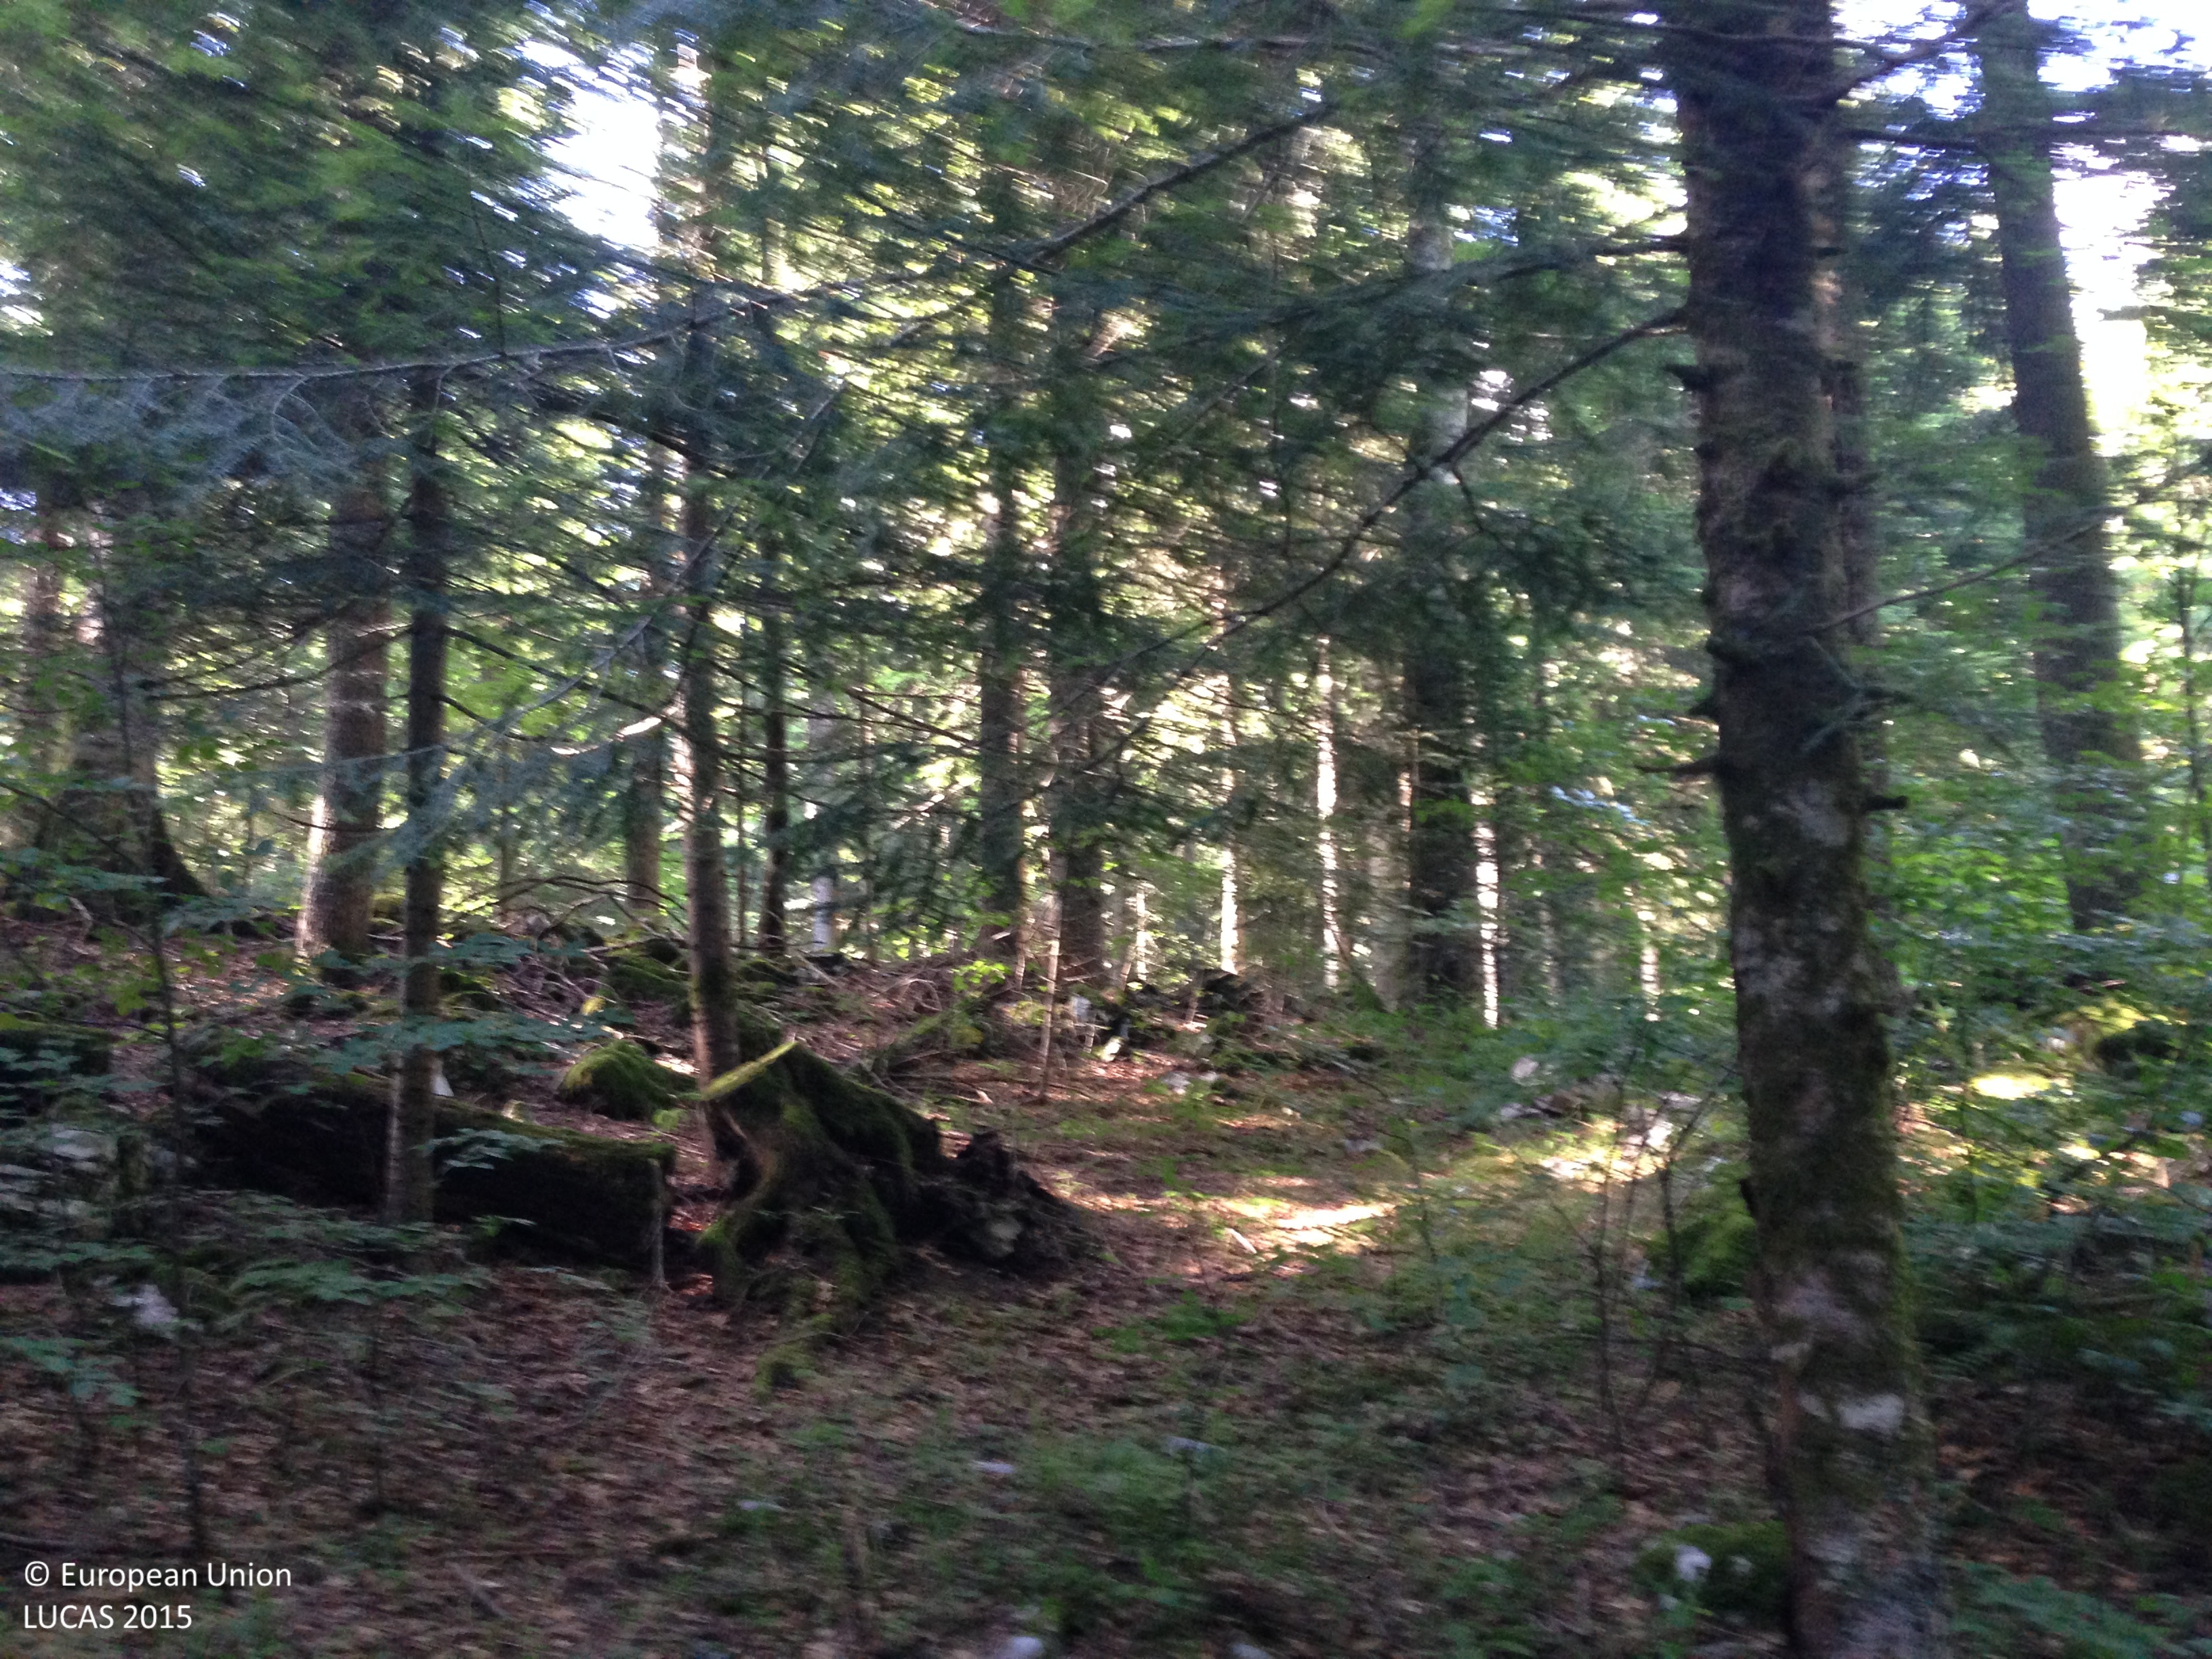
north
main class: Woodland
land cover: Other mixed woodland
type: thermophilous deciduous forest
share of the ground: > 75 %
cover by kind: broadleaved forest trees 45 %, coniferous forest trees 30 %, herbaceous plants 10 %, shrubs 5 %, lichens and mosses 5 %, unconsolidated bare surface 5 %
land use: Forestry
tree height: > 5 m
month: June
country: HR
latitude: 44.6385
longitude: 15.8311
